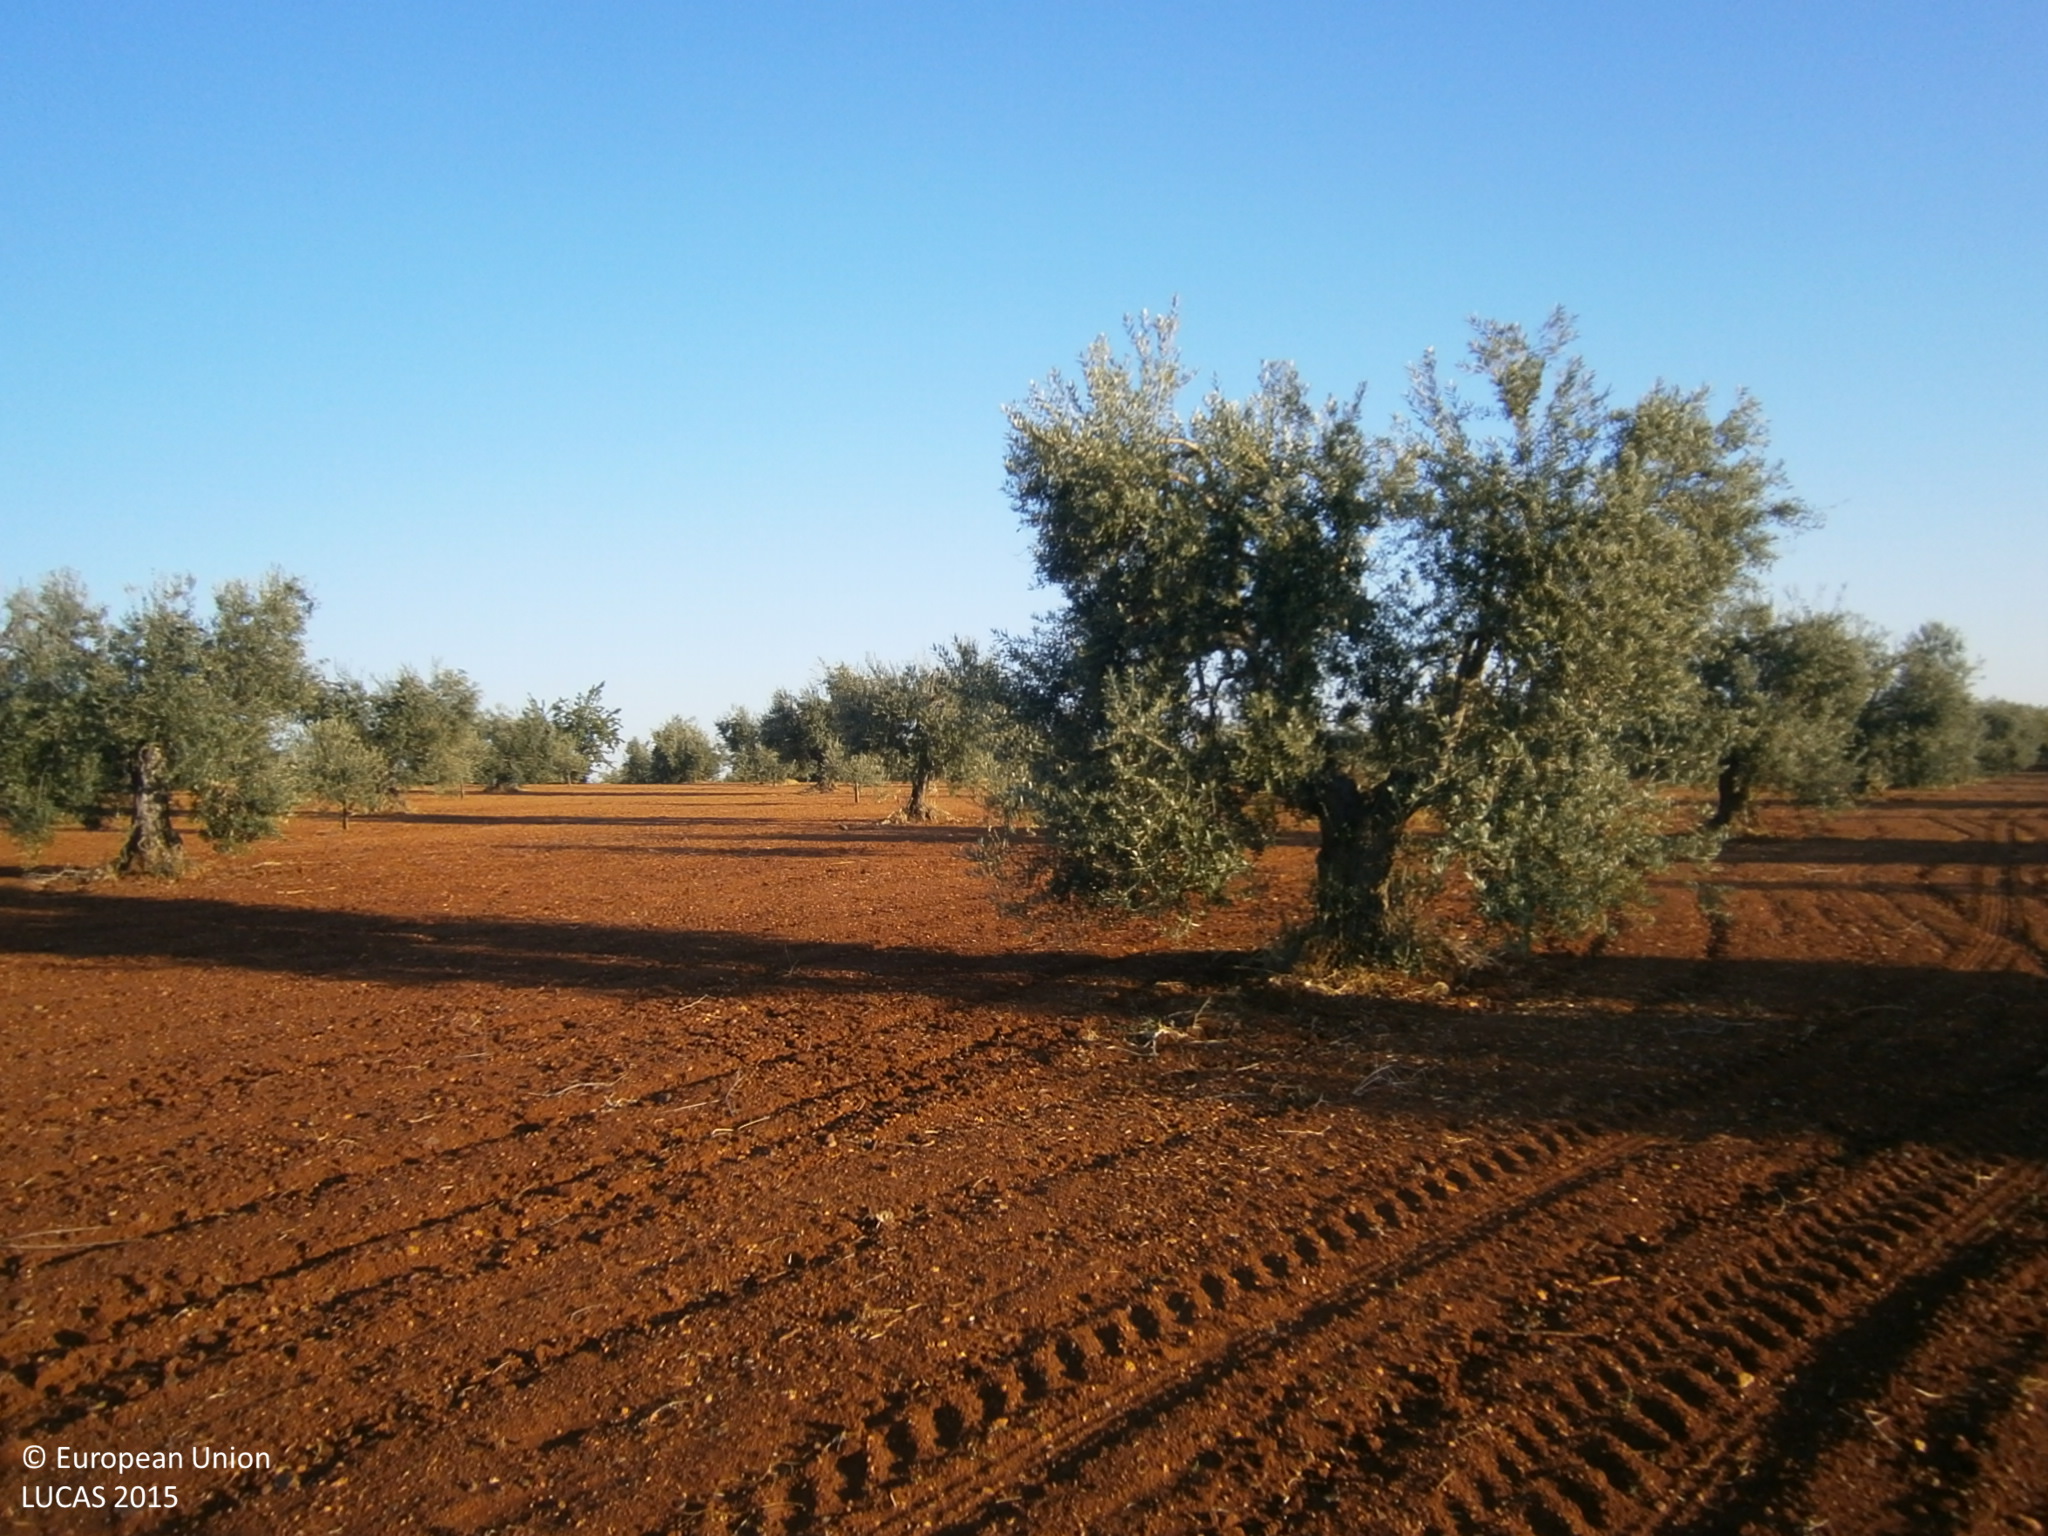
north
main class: Cropland
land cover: Olive groves
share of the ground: 10 - 25 %
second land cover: Other bare soil
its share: > 75 %
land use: Agriculture (excluding fallow land and kitchen gardens)
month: June
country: ES
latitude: 38.6782
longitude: -6.6933
